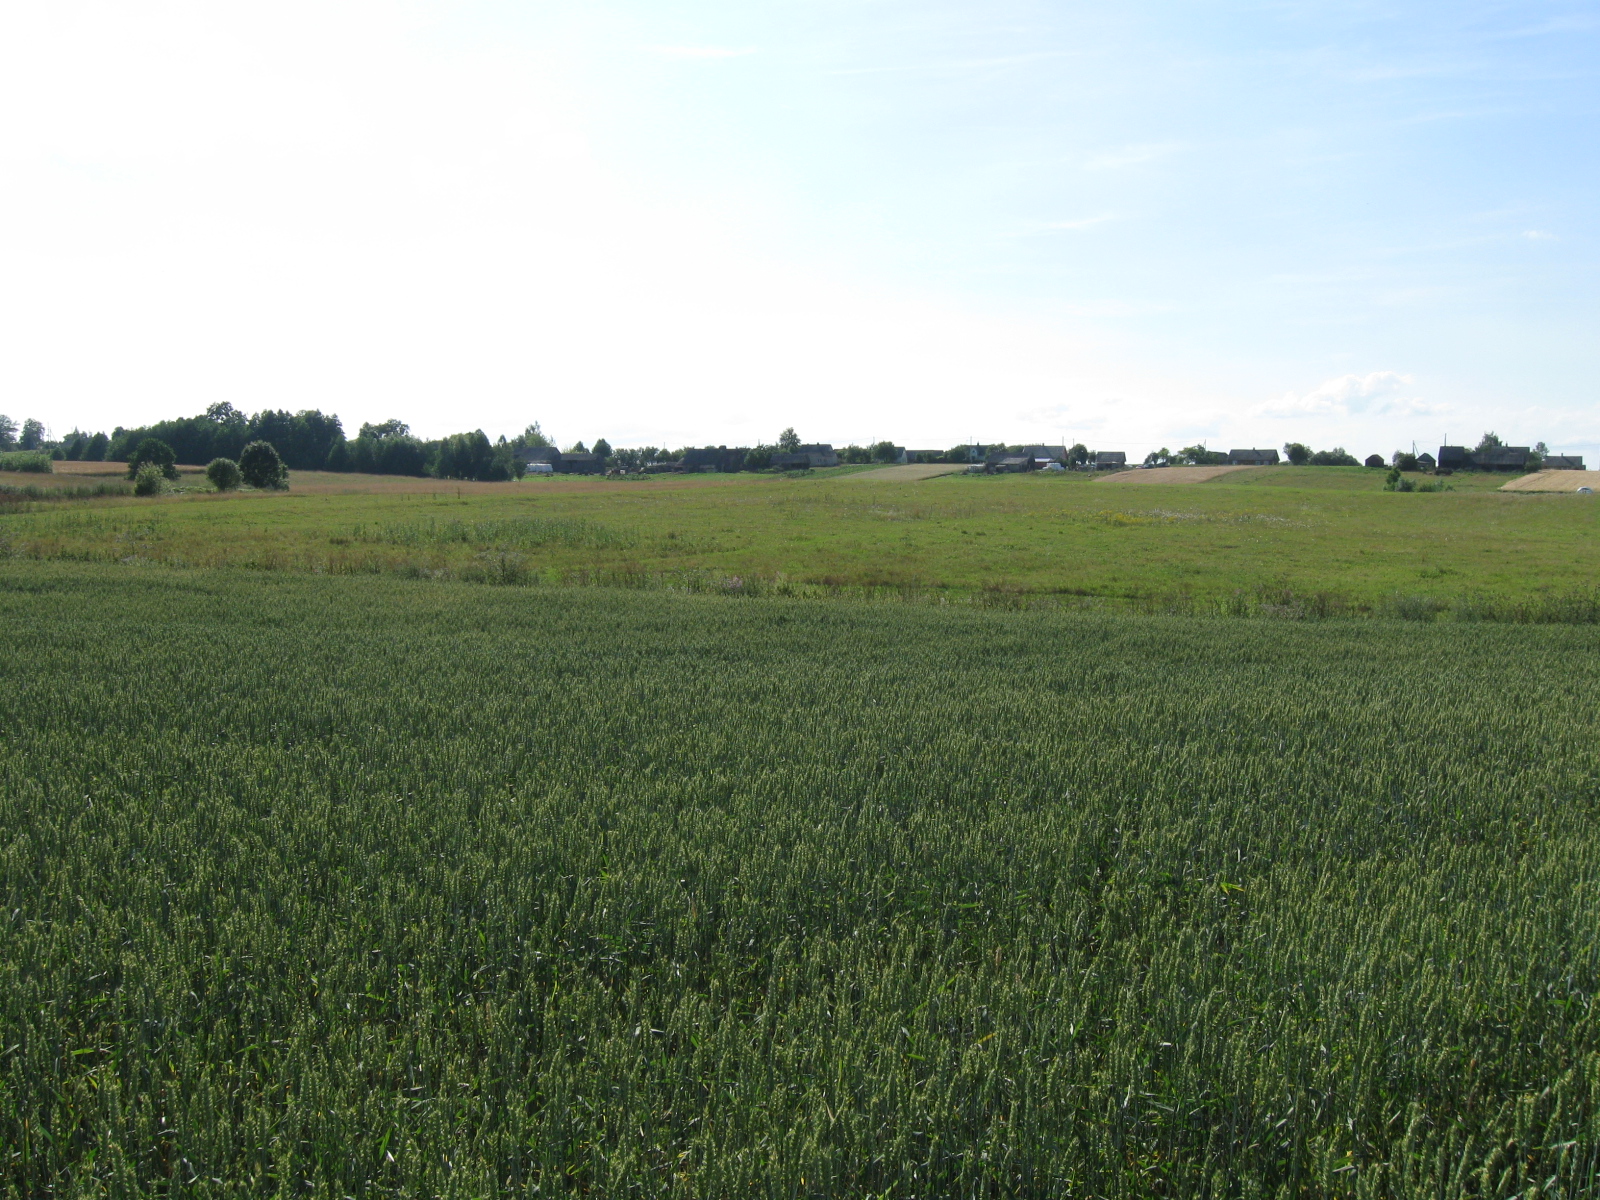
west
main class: Cropland
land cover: Common wheat
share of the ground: > 75 %
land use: Agriculture (excluding fallow land and kitchen gardens)
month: July
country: LT
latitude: 54.3295
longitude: 23.4128
